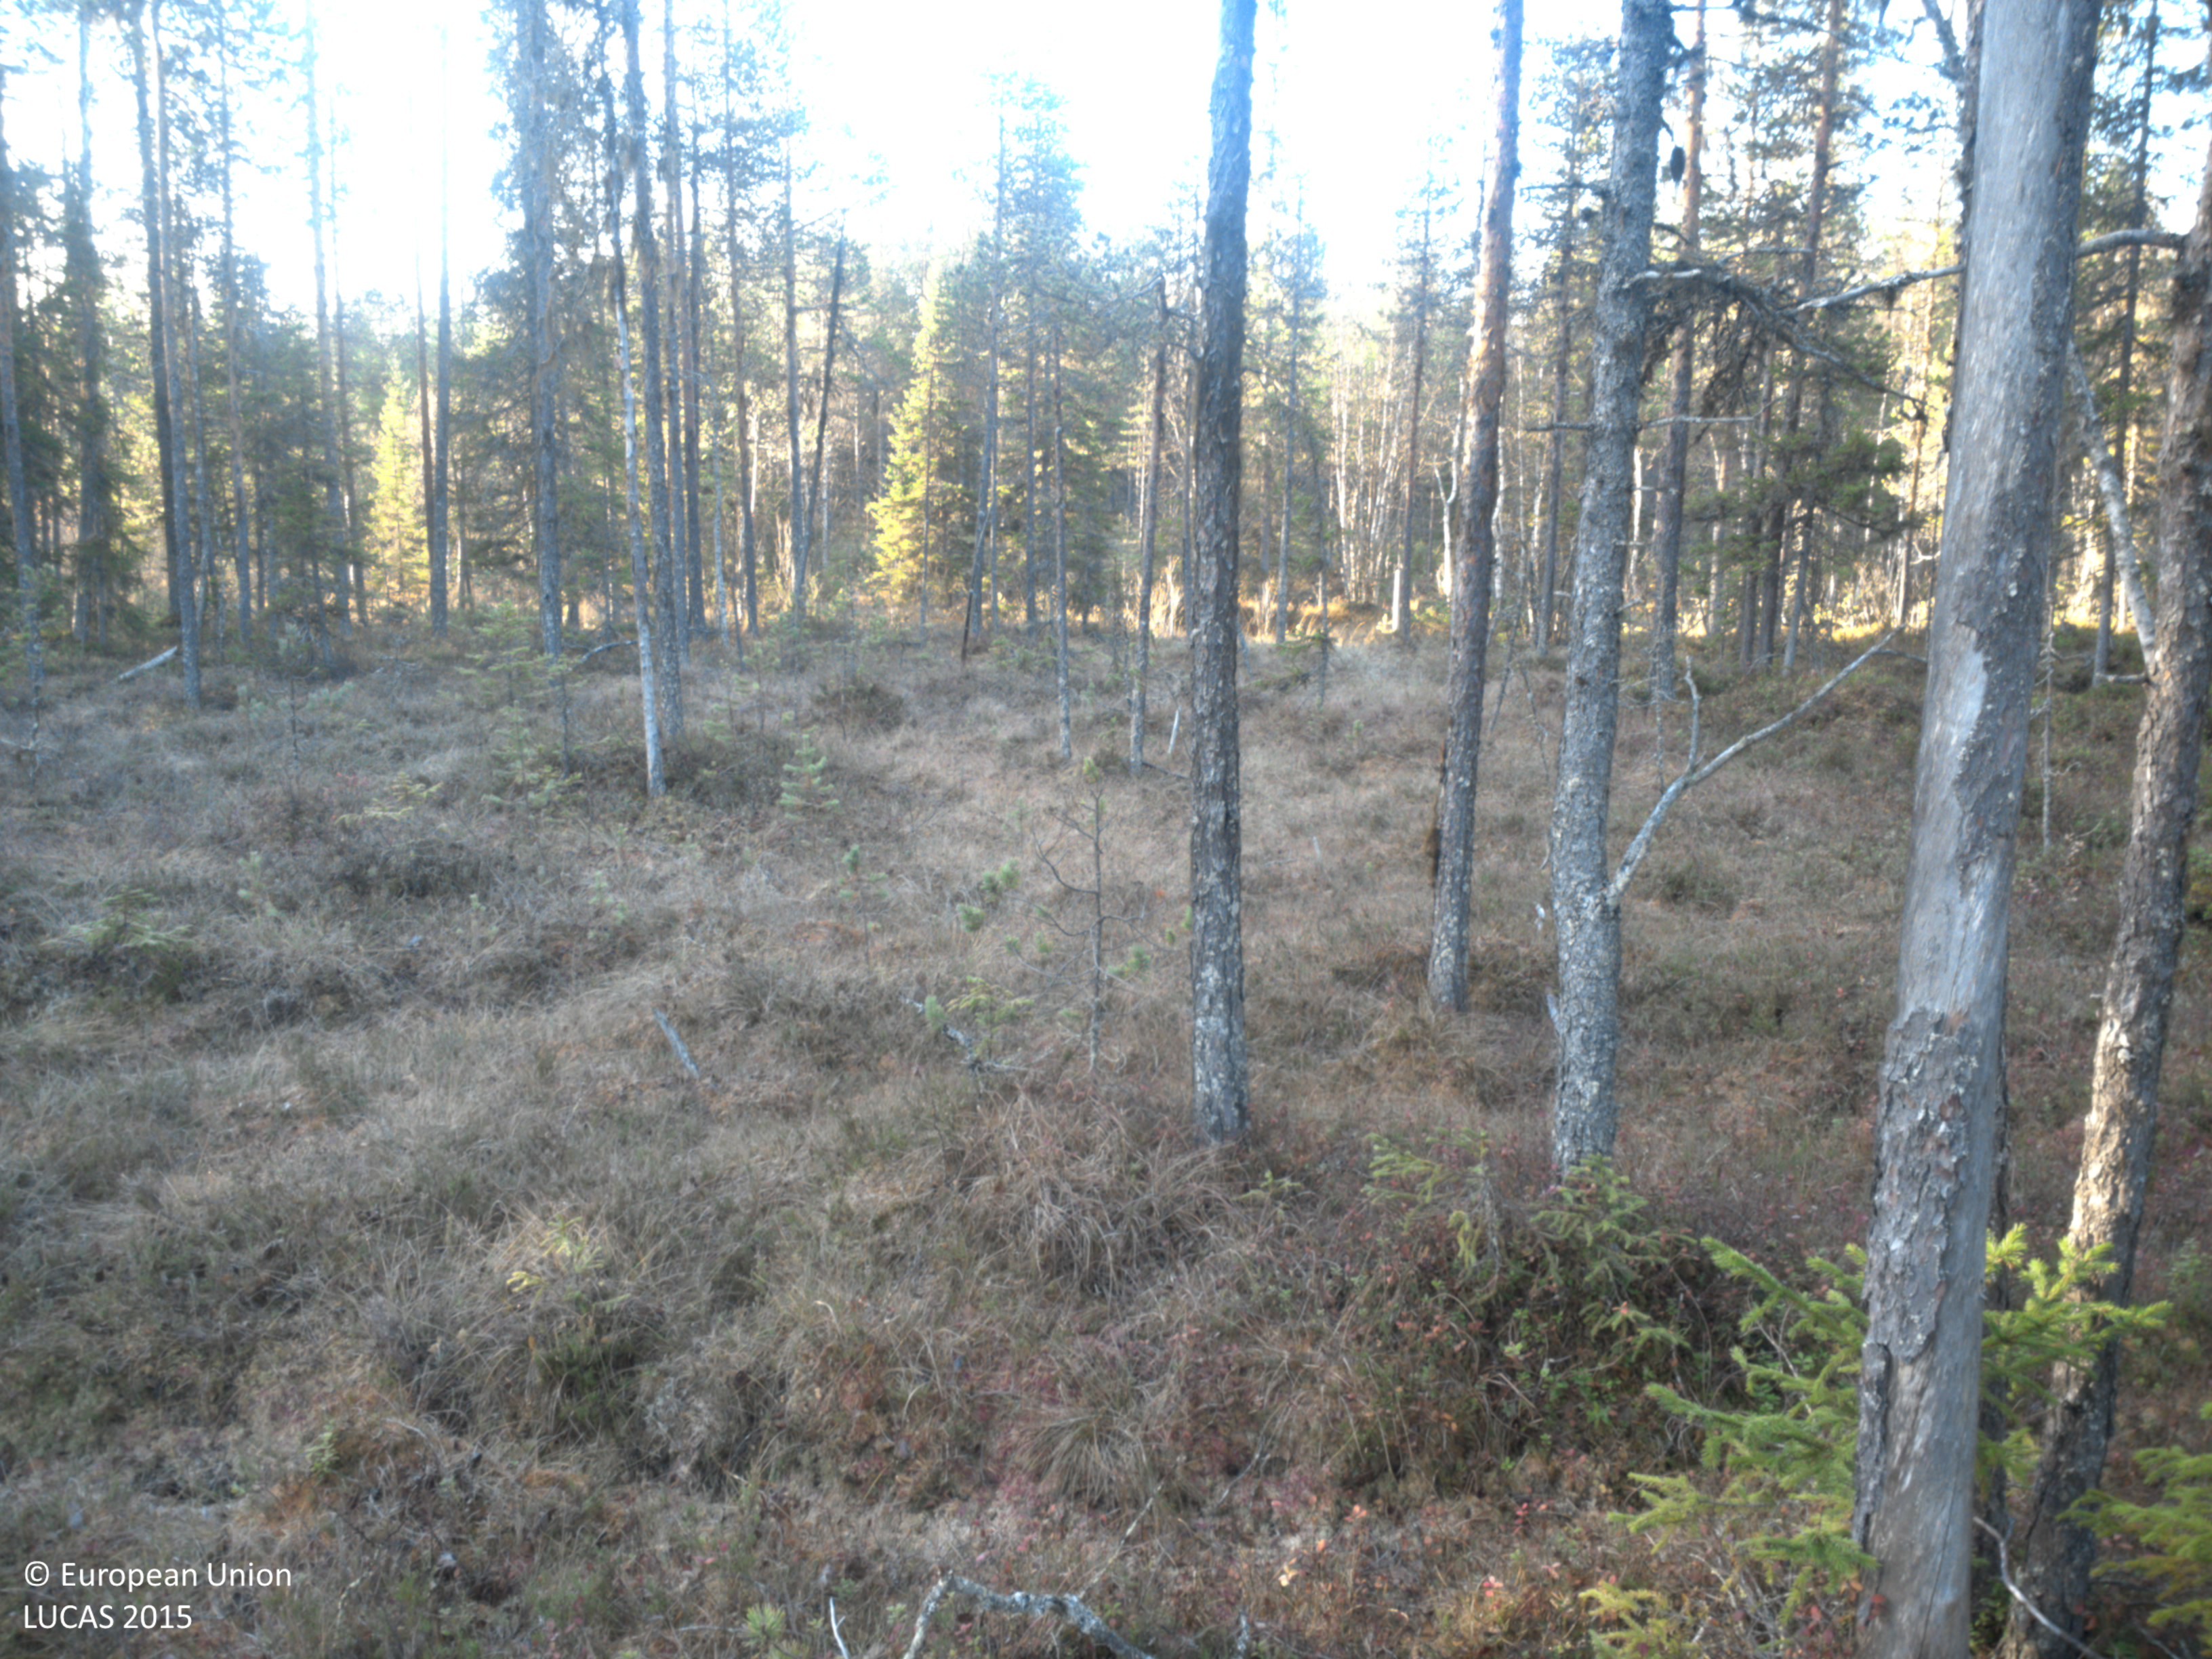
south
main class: Woodland
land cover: Pine dominated mixed woodland
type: boreal forest
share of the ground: 50 - 75 %
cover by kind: coniferous forest trees 35 %, shrubs 30 %, broadleaved forest trees 15 %, herbaceous plants 15 %, lichens and mosses 5 %
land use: Forestry
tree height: > 5 m
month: October
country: SE
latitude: 64.8177
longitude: 18.2854
